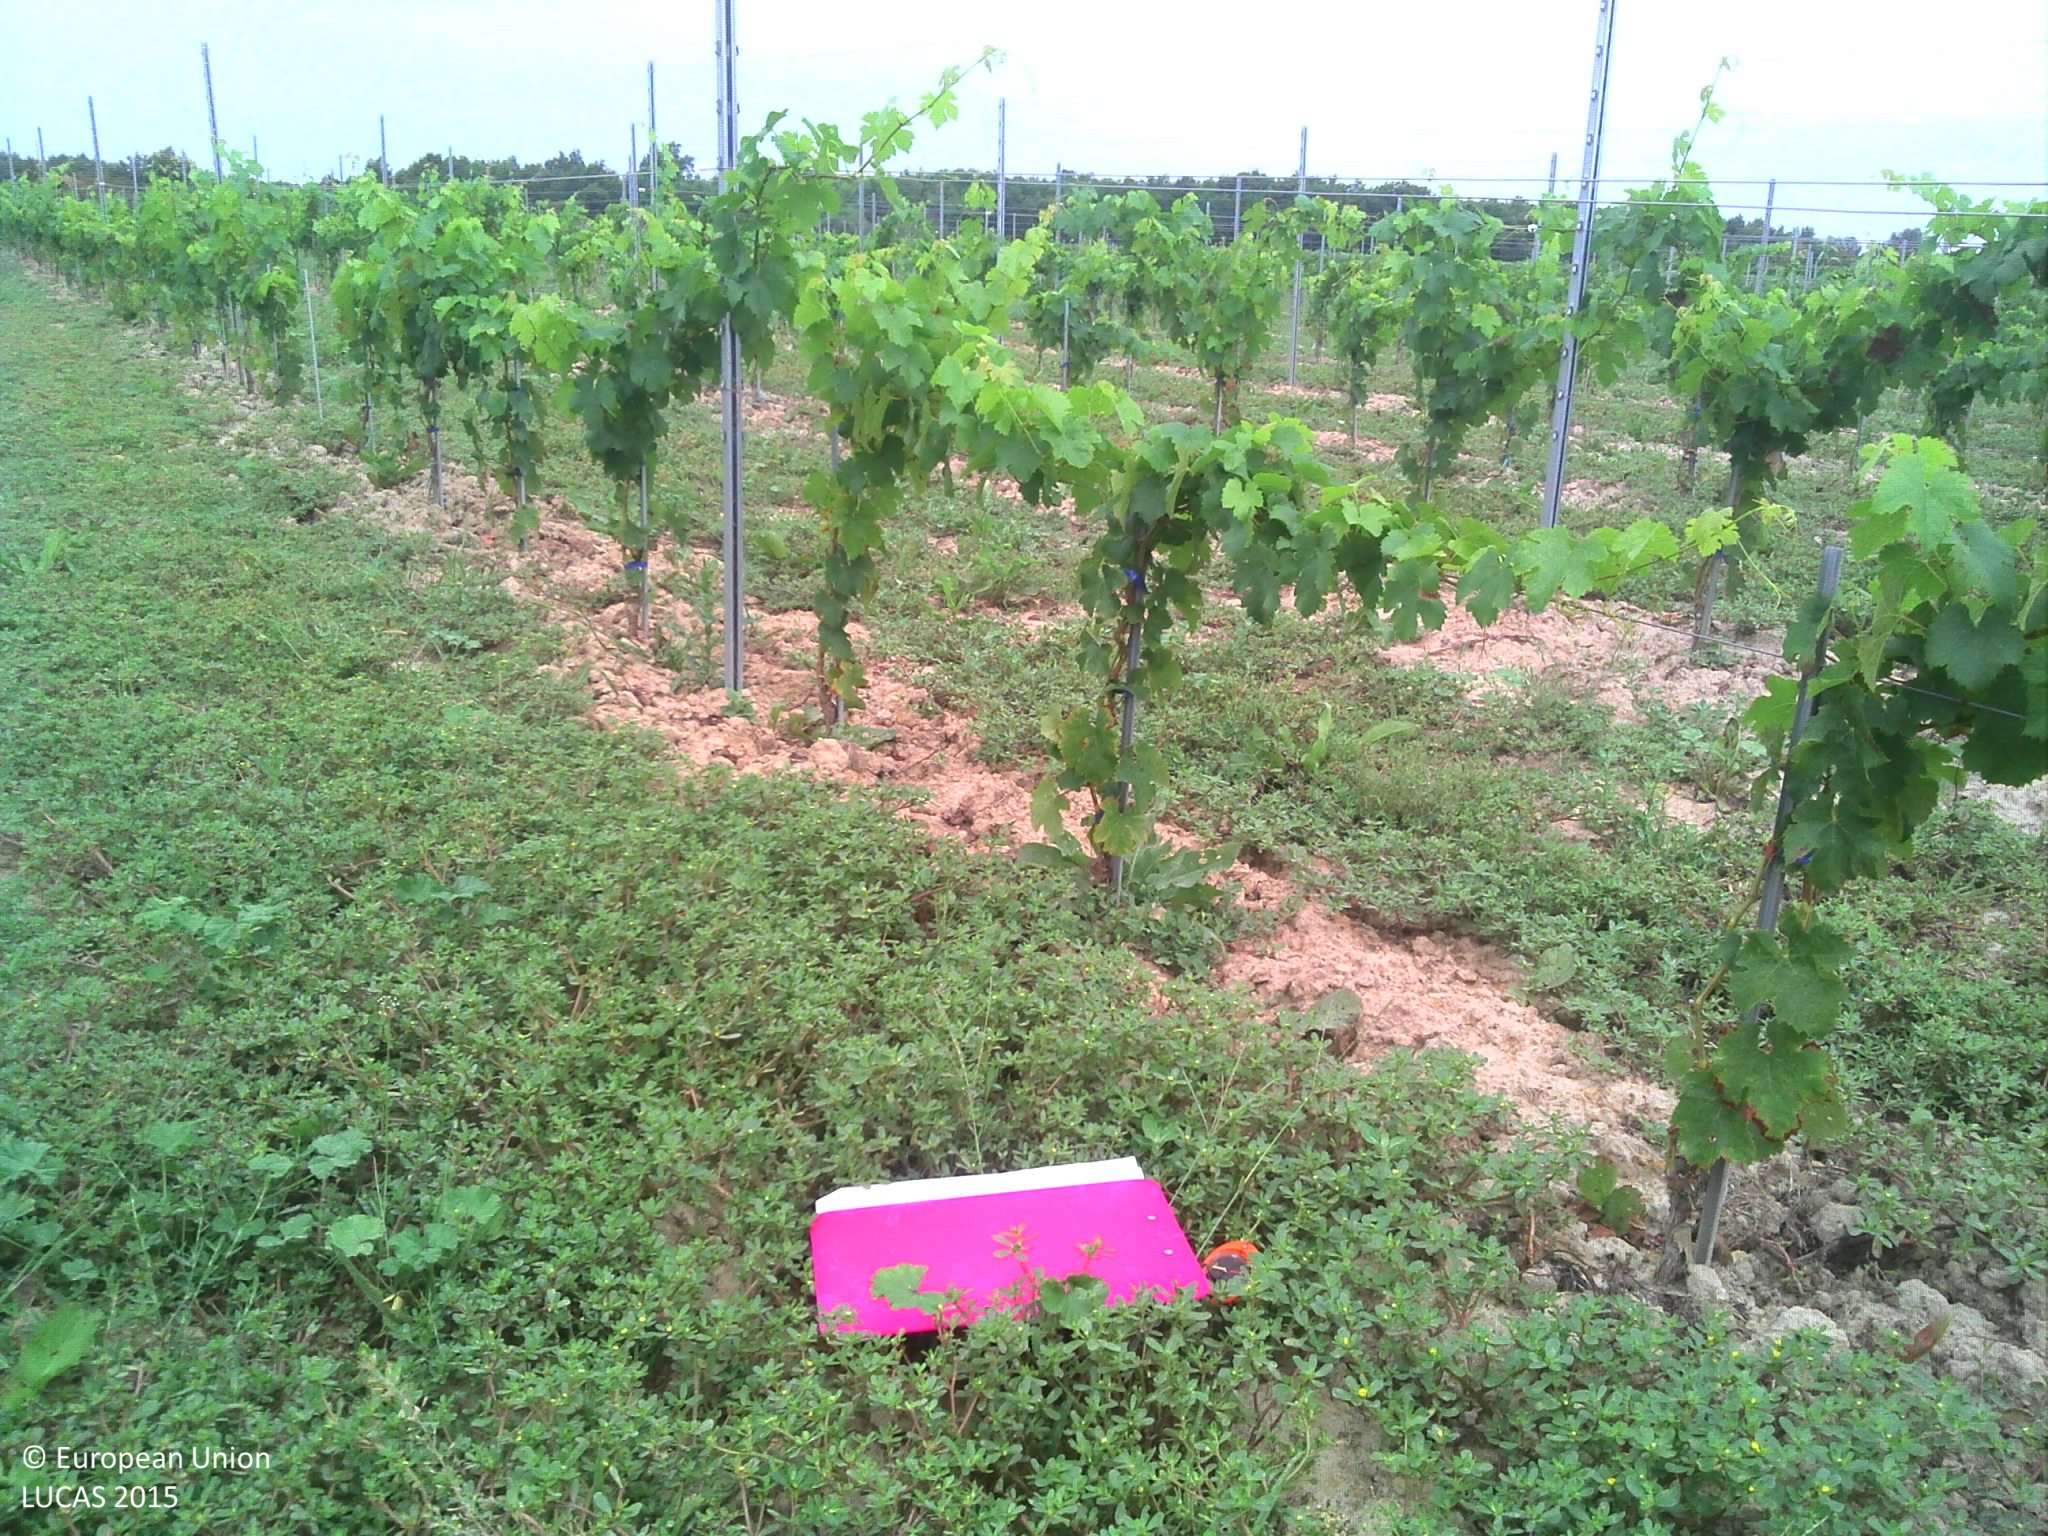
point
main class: Cropland
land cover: Vineyards
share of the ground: 25 - 50 %
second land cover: Spontaneously vegetated surfaces
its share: > 75 %
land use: Agriculture (excluding fallow land and kitchen gardens)
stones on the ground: < 10 %
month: August
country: FR
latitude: 43.8980
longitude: 1.3481
